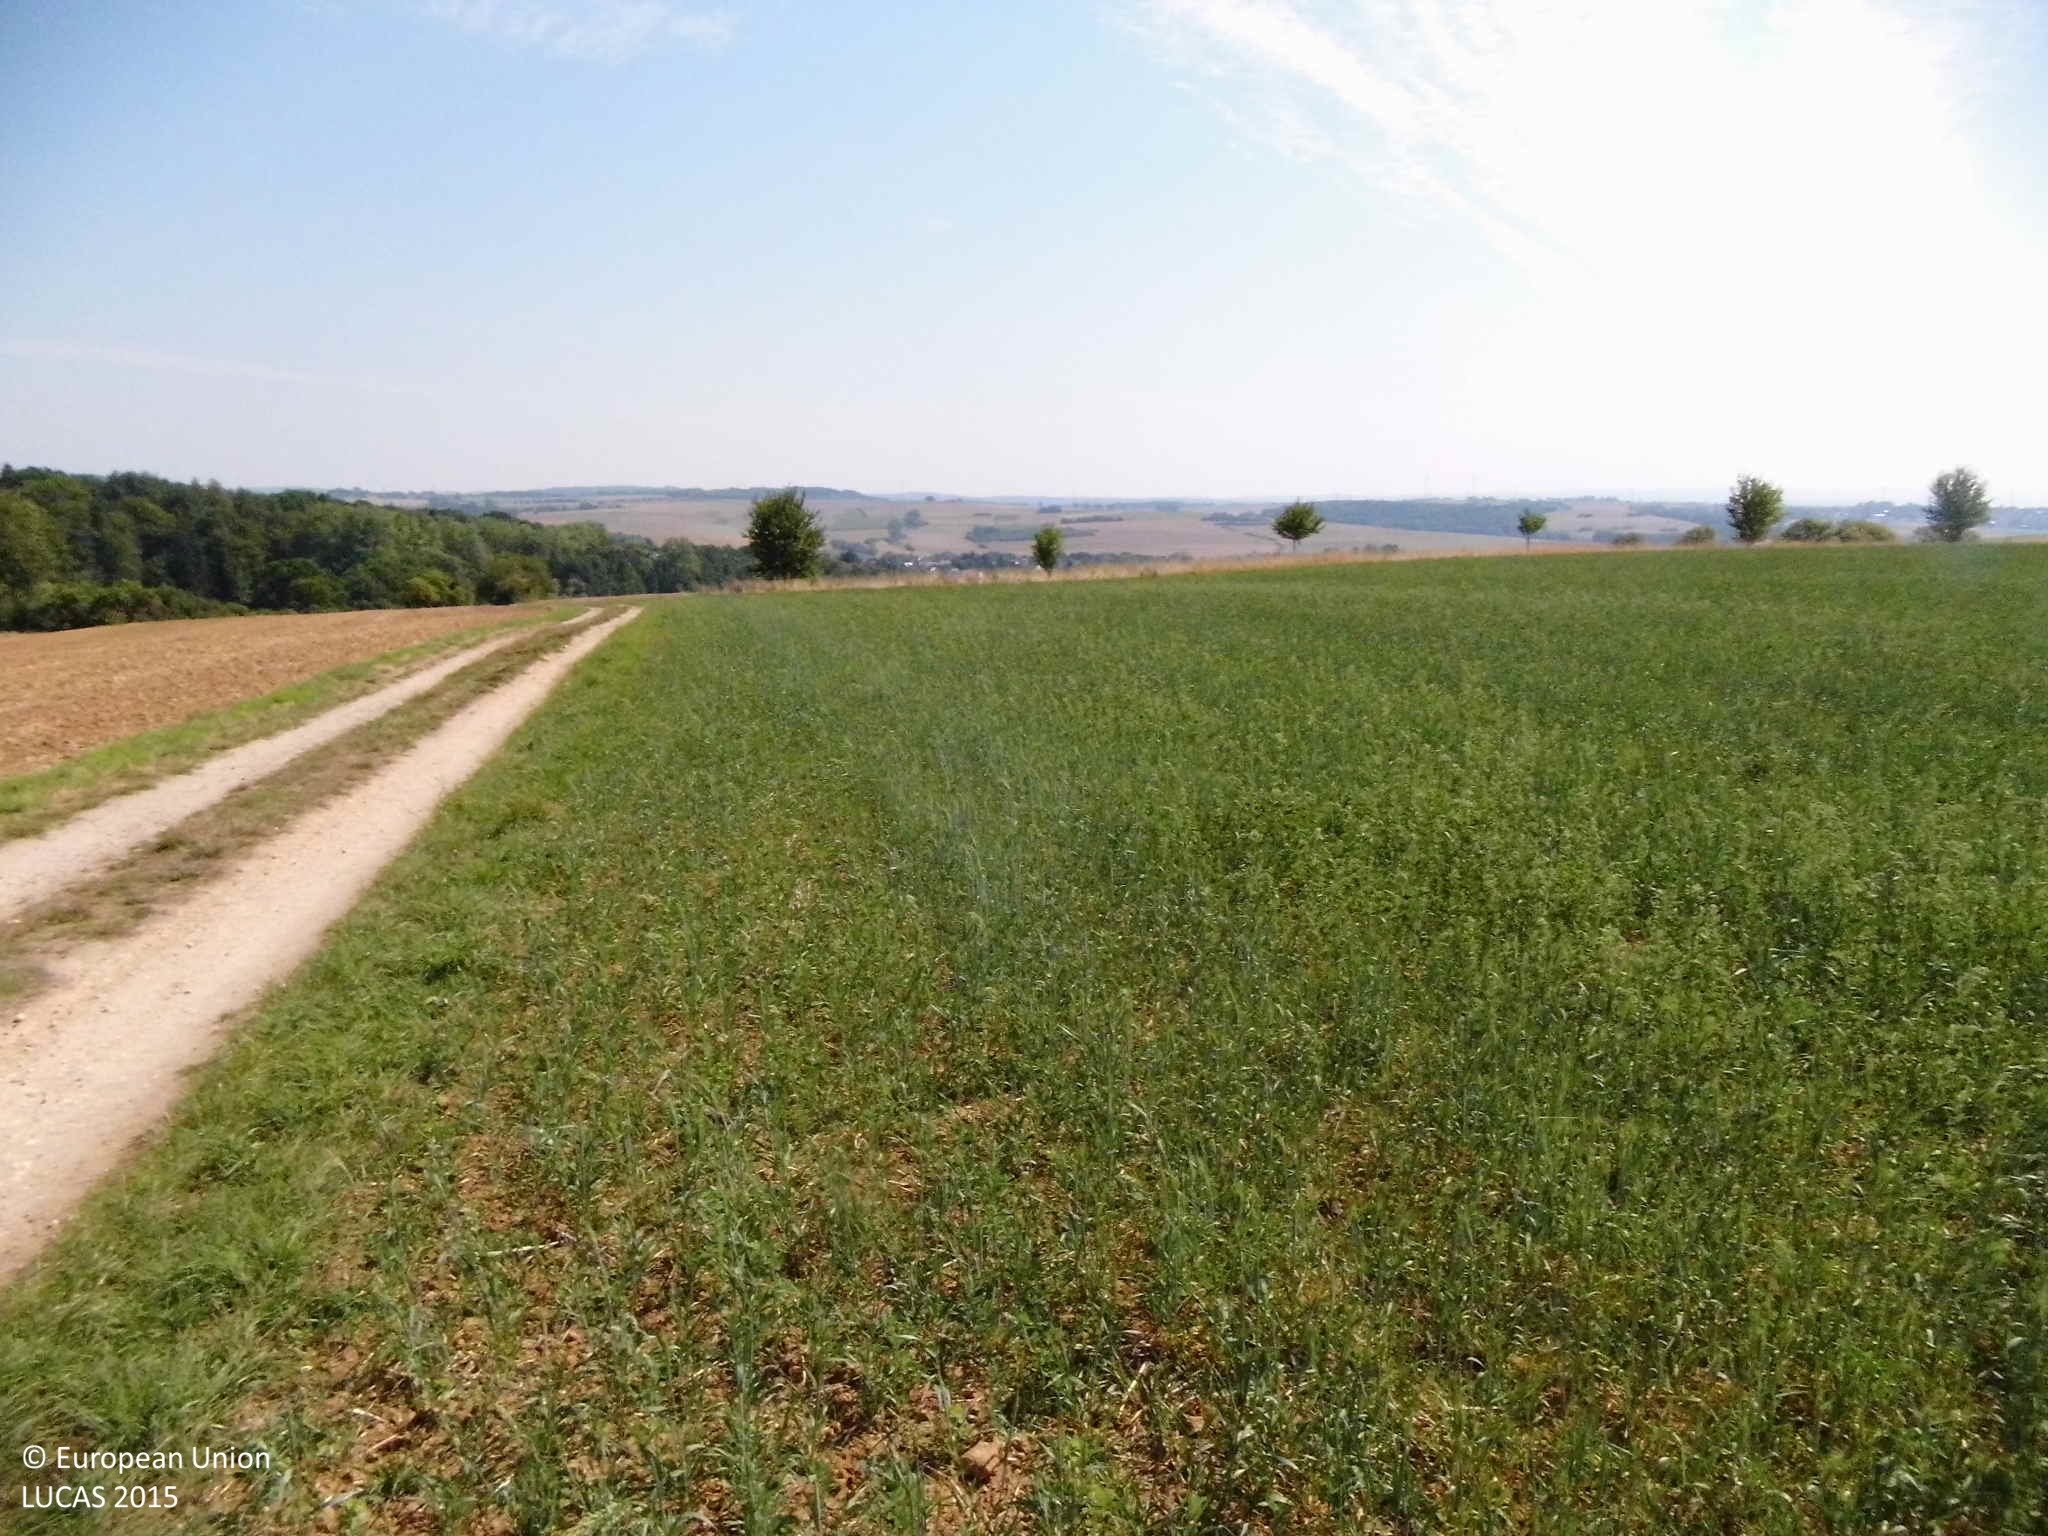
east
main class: Cropland
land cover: Rye
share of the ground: 25 - 50 %
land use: Agriculture (excluding fallow land and kitchen gardens)
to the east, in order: Grass margins; Rye; Tracks; Grass margins; Grassland with sparse tree/shrub cover; Rye; Other bare soil
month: August
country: DE
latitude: 50.4368
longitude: 8.0152
